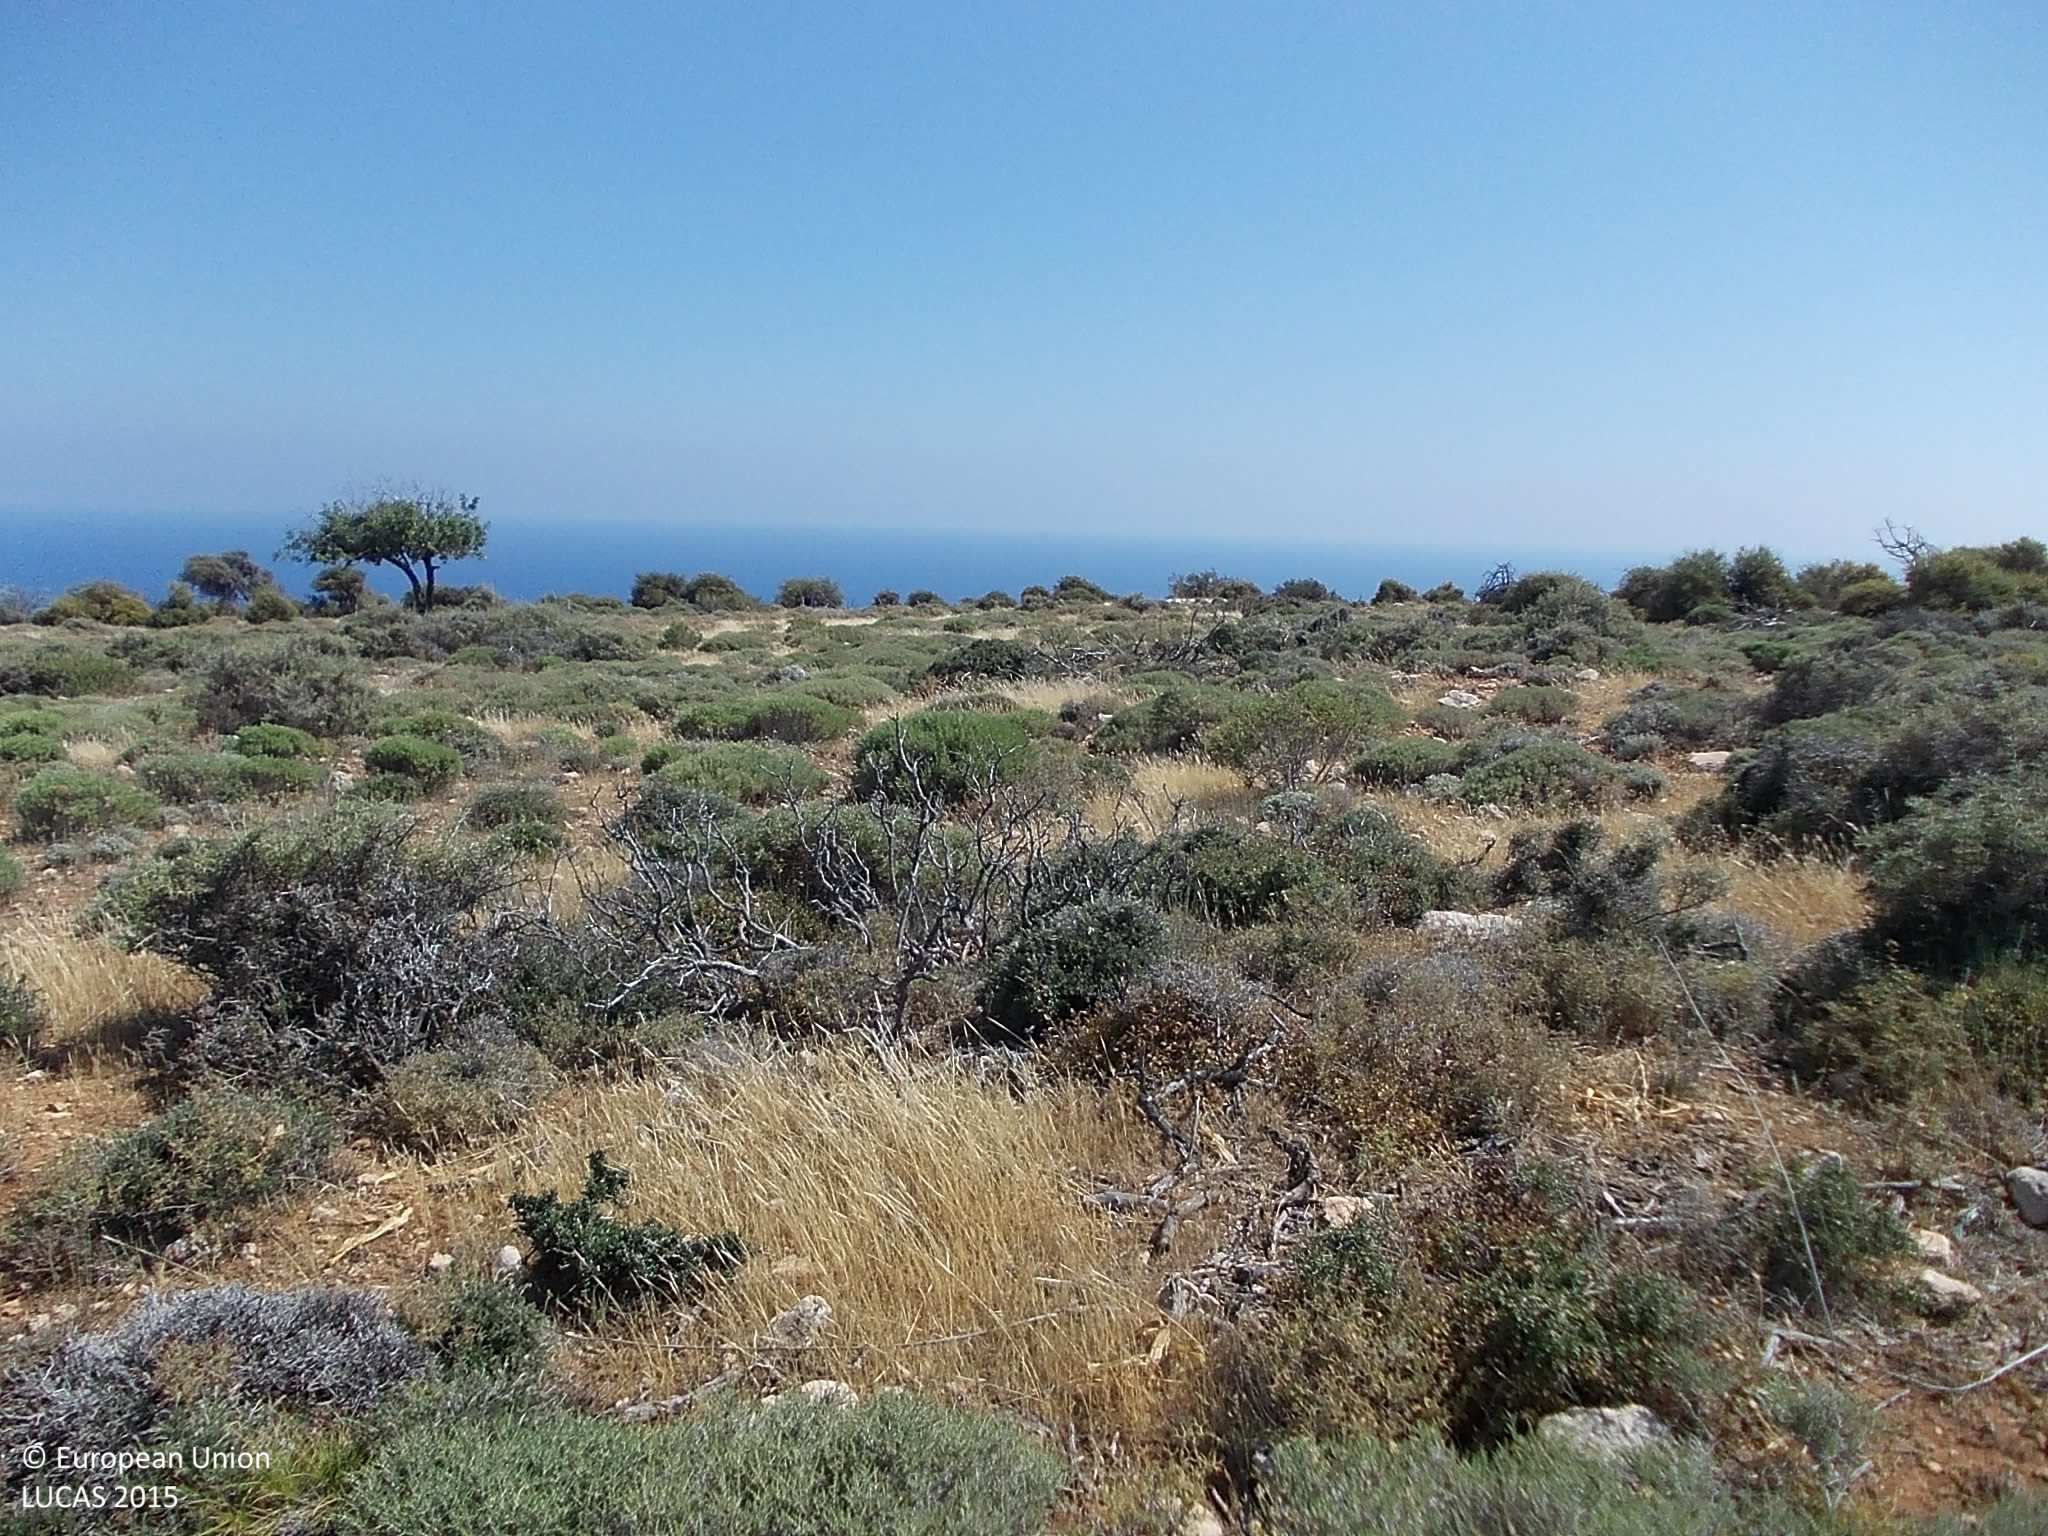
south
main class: Shrubland
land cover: Shrubland without tree cover
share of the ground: > 75 %
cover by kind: shrubs 75 %, unconsolidated bare surface 15 %, herbaceous plants 10 %
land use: Semi-natural and natural areas not in use
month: June
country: CY
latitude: 34.6450
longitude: 32.7012
